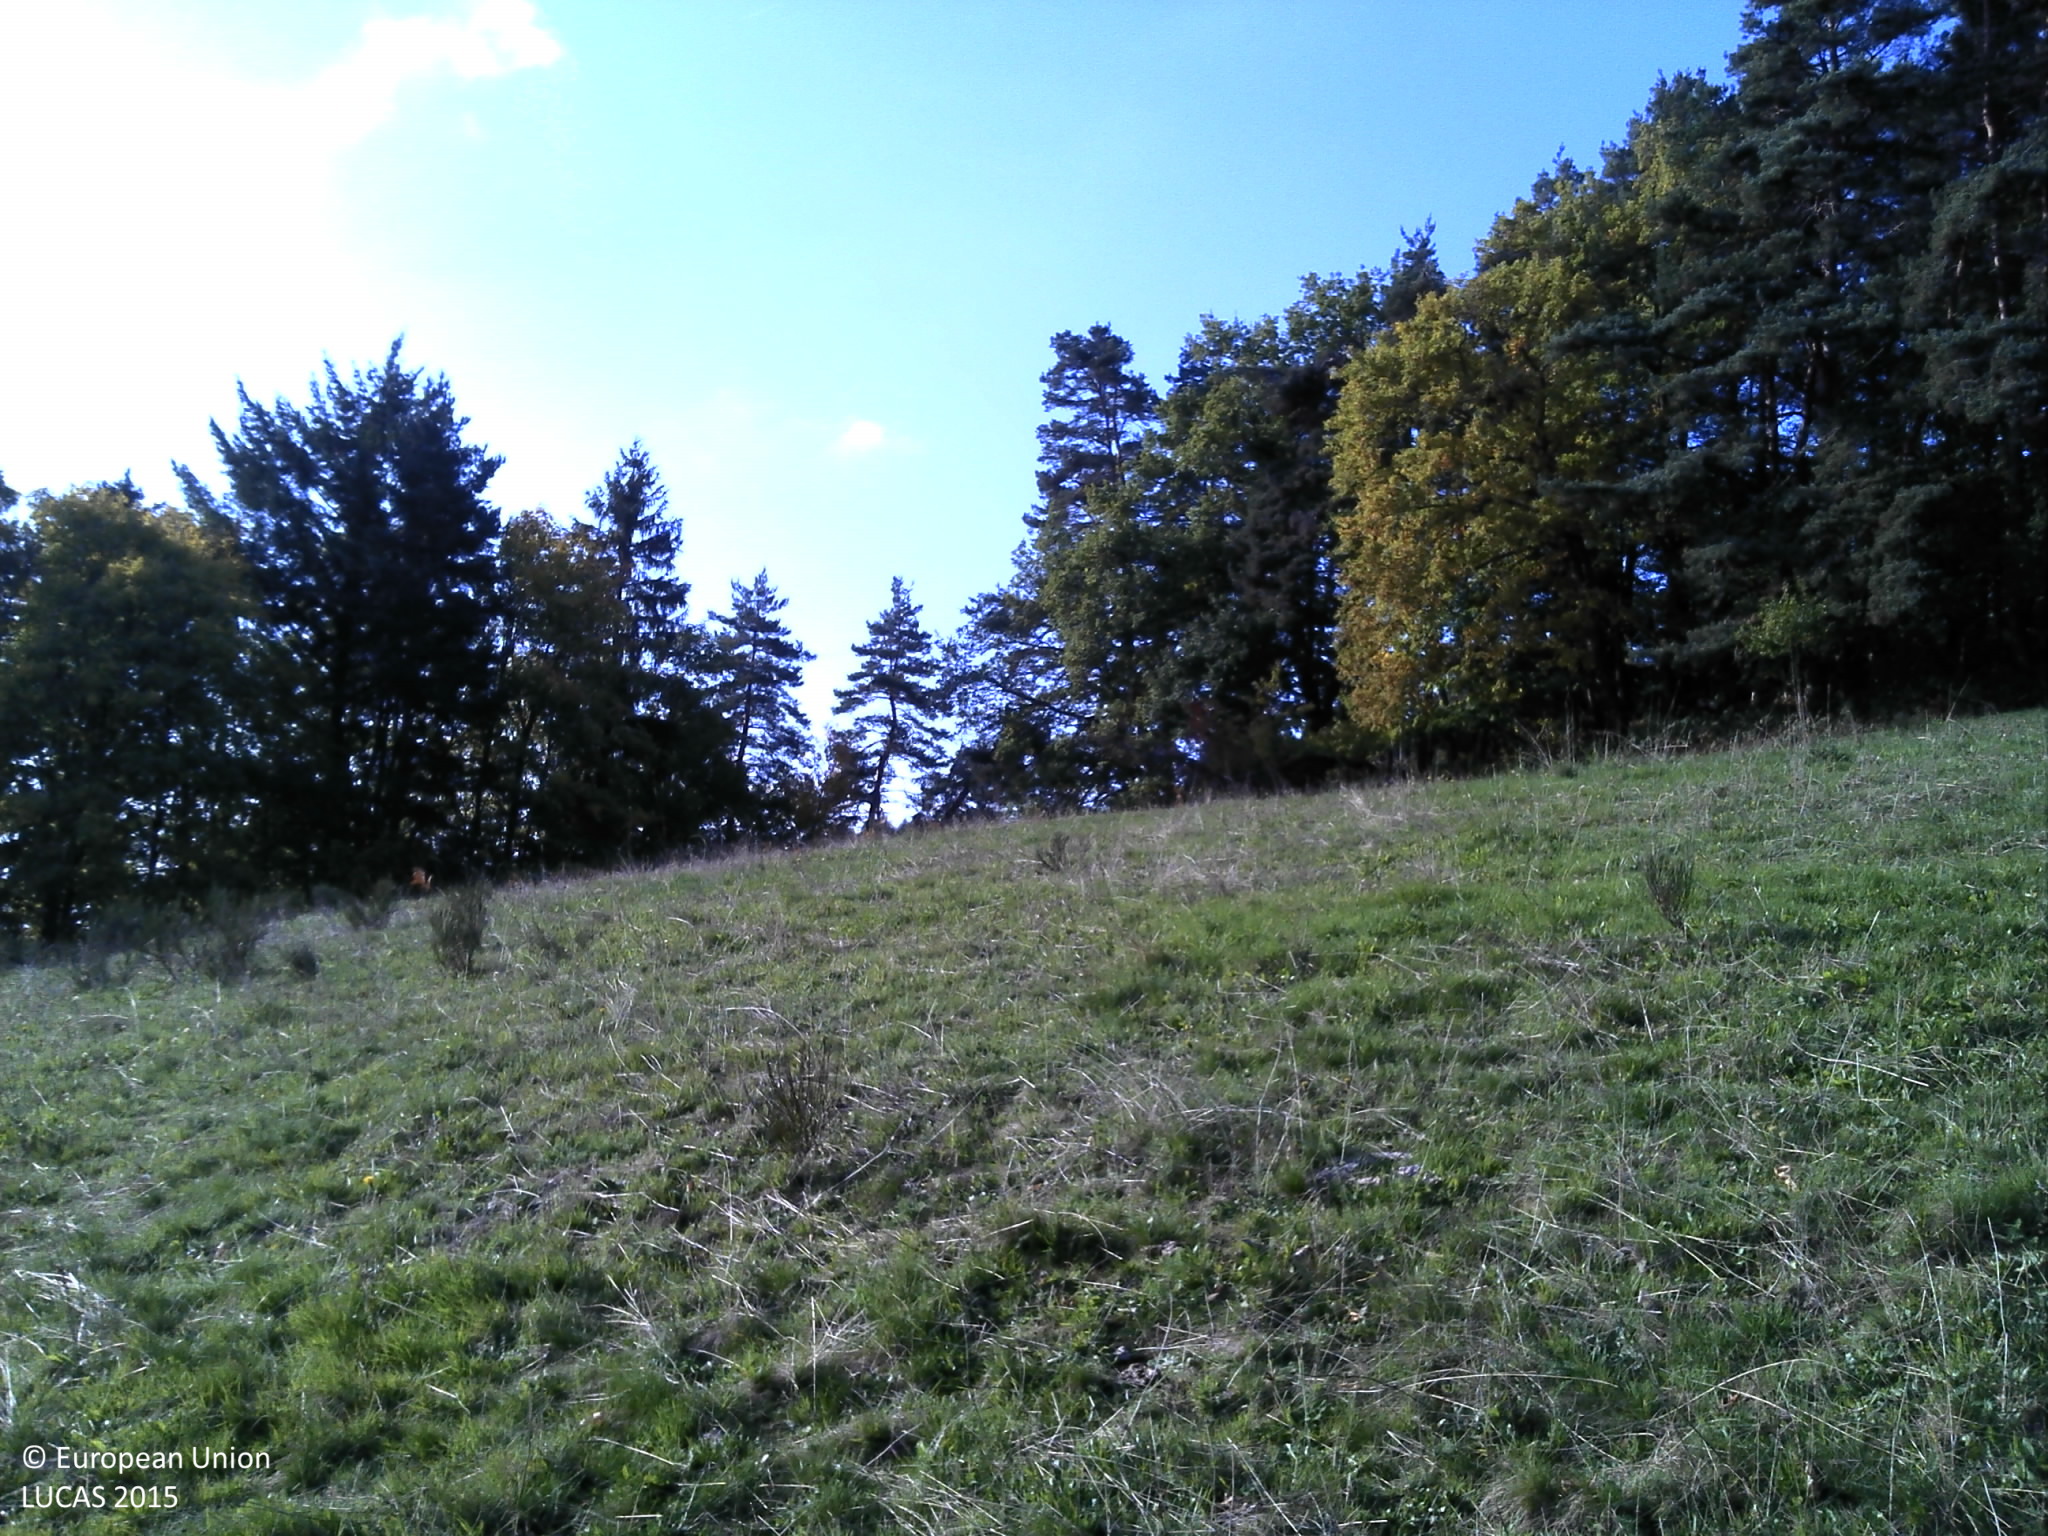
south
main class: Grassland
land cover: Grassland without tree/shrub cover
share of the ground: > 75 %
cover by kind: herbaceous plants 100 %
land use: Agriculture (excluding fallow land and kitchen gardens)
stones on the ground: < 10 %
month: October
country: FR
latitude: 45.5878
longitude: 3.7086
